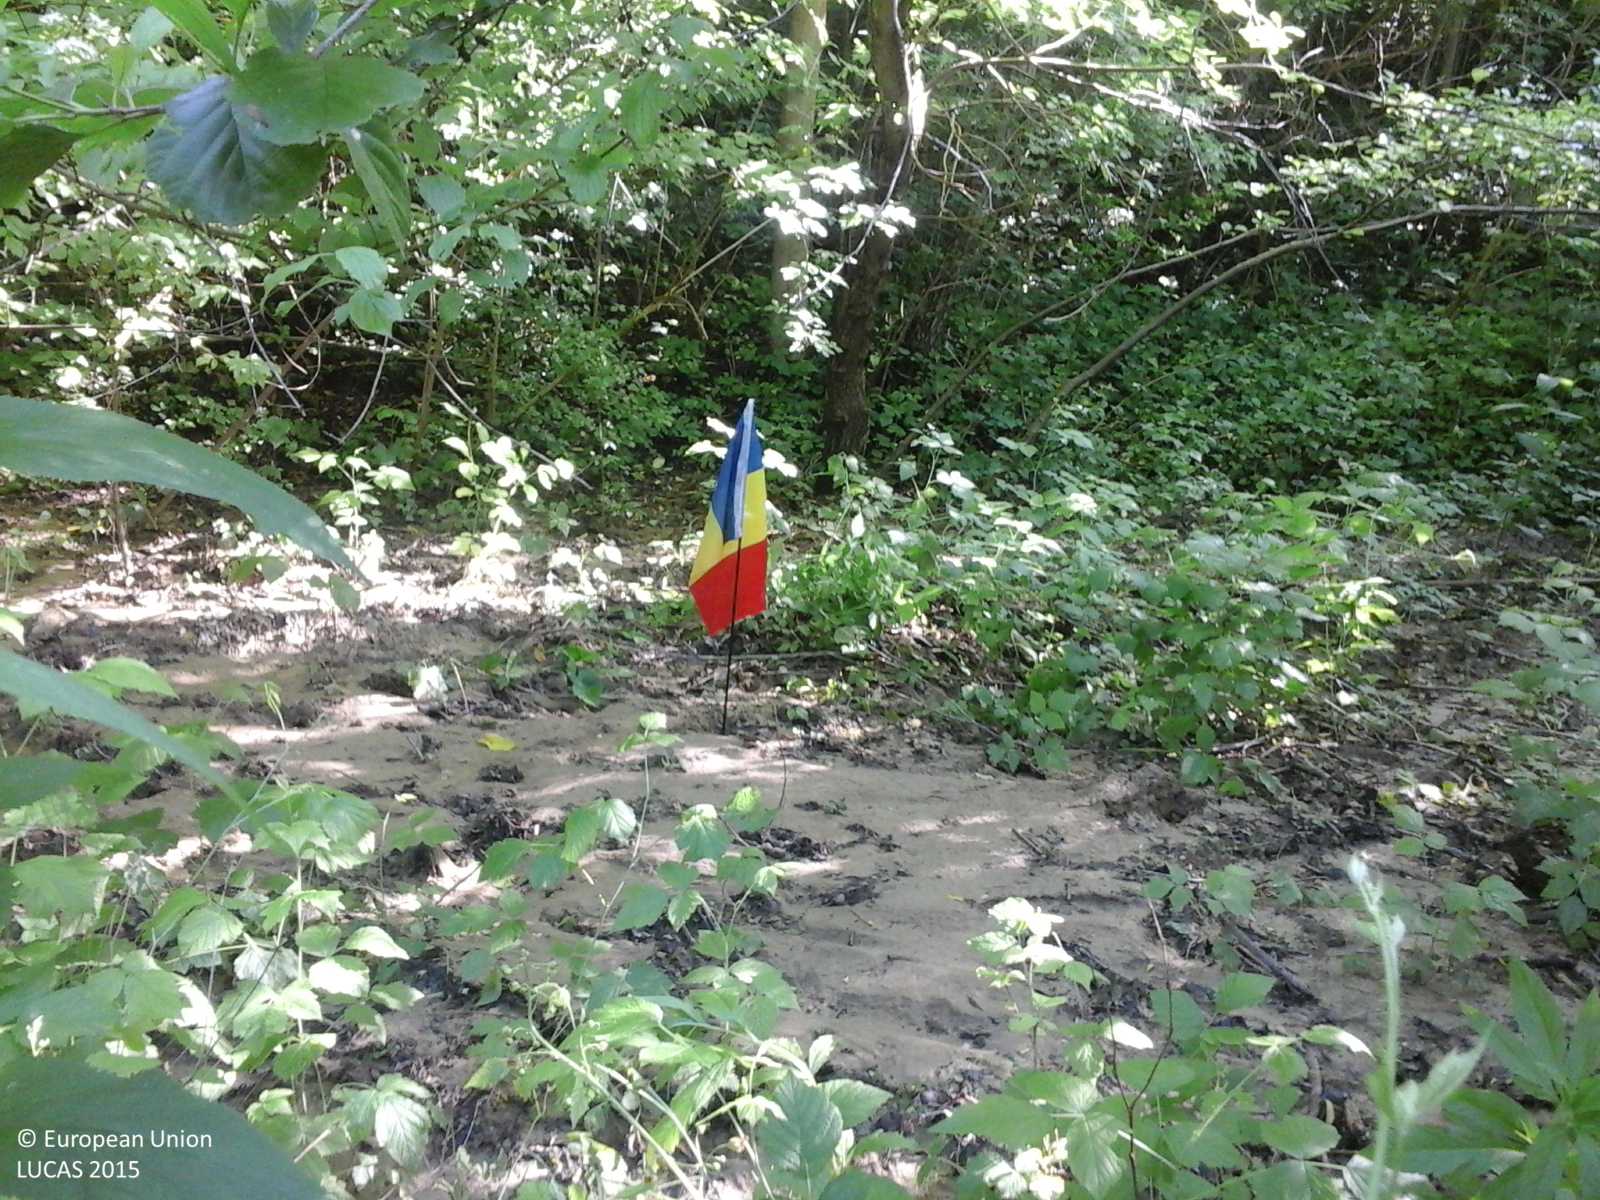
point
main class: Woodland
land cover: Broadleaved woodland
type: mesophytic deciduous forest
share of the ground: > 75 %
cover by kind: broadleaved forest trees 100 %
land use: Forestry
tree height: > 5 m
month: May
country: RO
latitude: 45.2026
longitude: 26.1678
